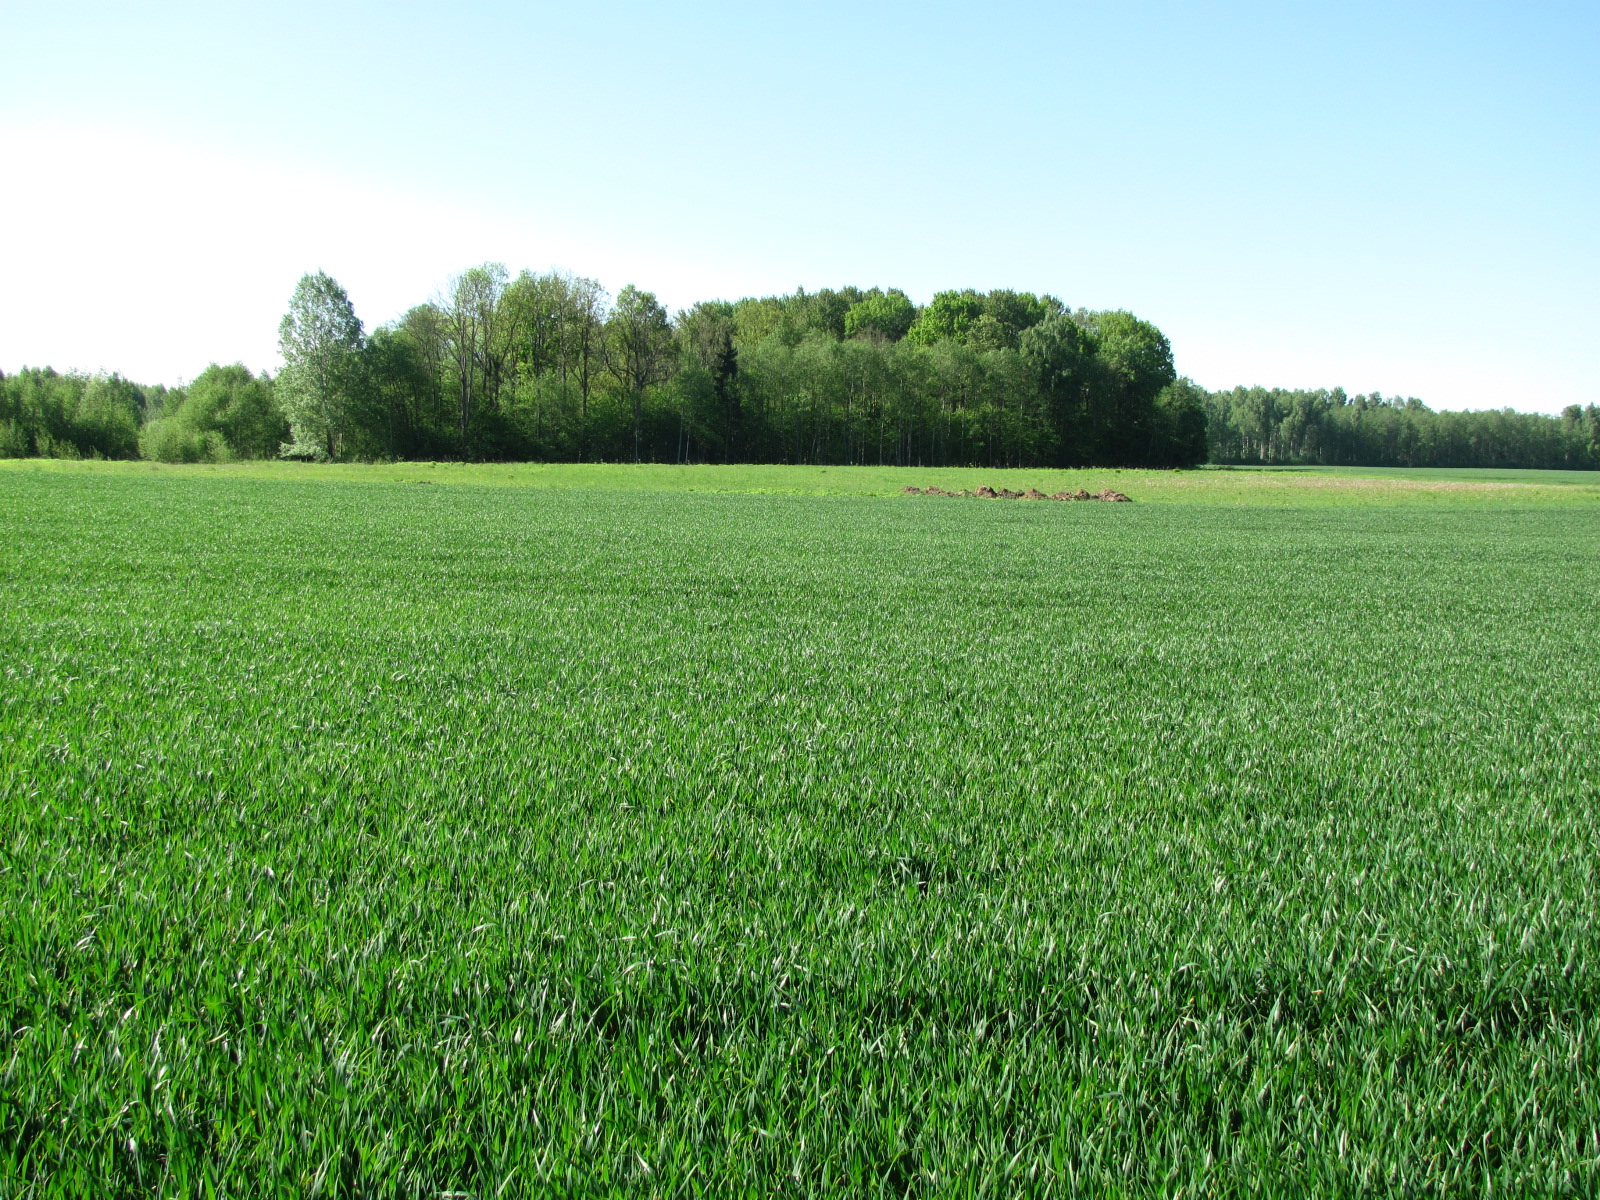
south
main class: Cropland
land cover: Common wheat
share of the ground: > 75 %
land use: Agriculture (excluding fallow land and kitchen gardens)
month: May
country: LV
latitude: 56.5741
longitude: 24.1015
